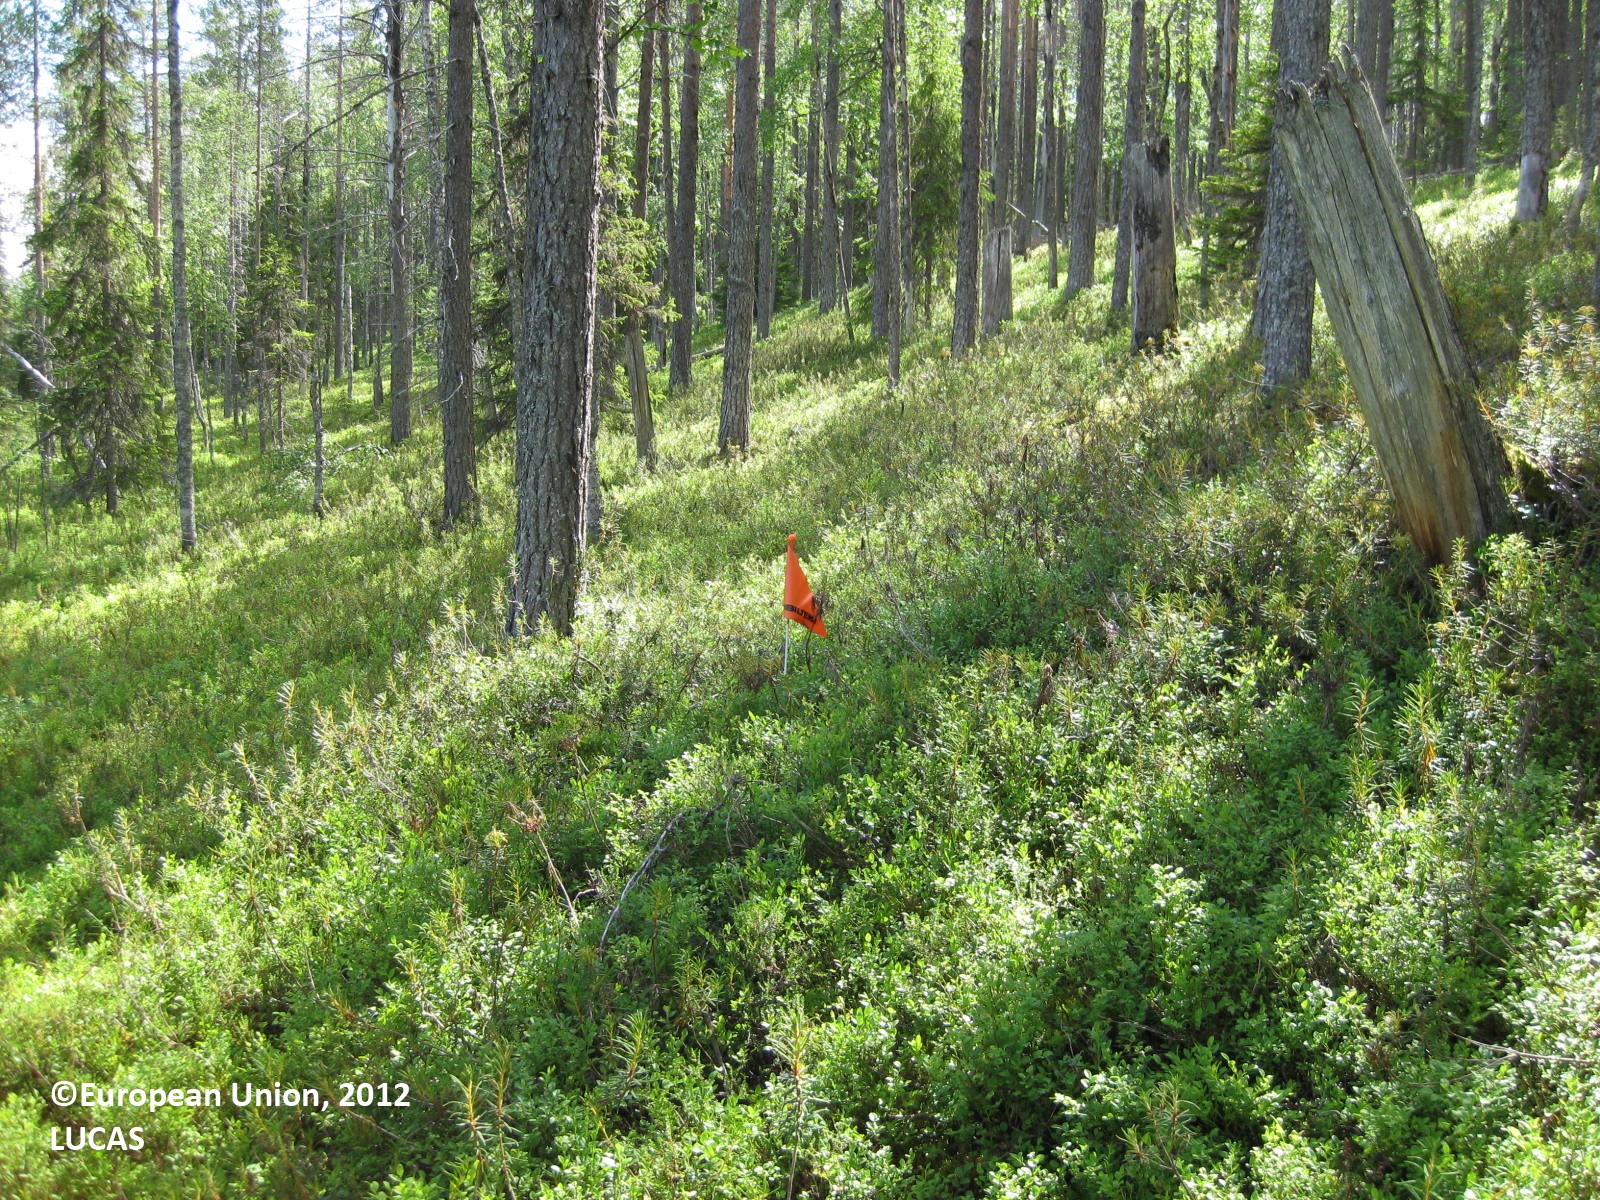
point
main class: Woodland
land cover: Pine dominated mixed woodland
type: boreal forest
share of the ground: > 75 %
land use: Forestry
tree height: > 5 m
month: July
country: FI
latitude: 65.6936
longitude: 29.8707
